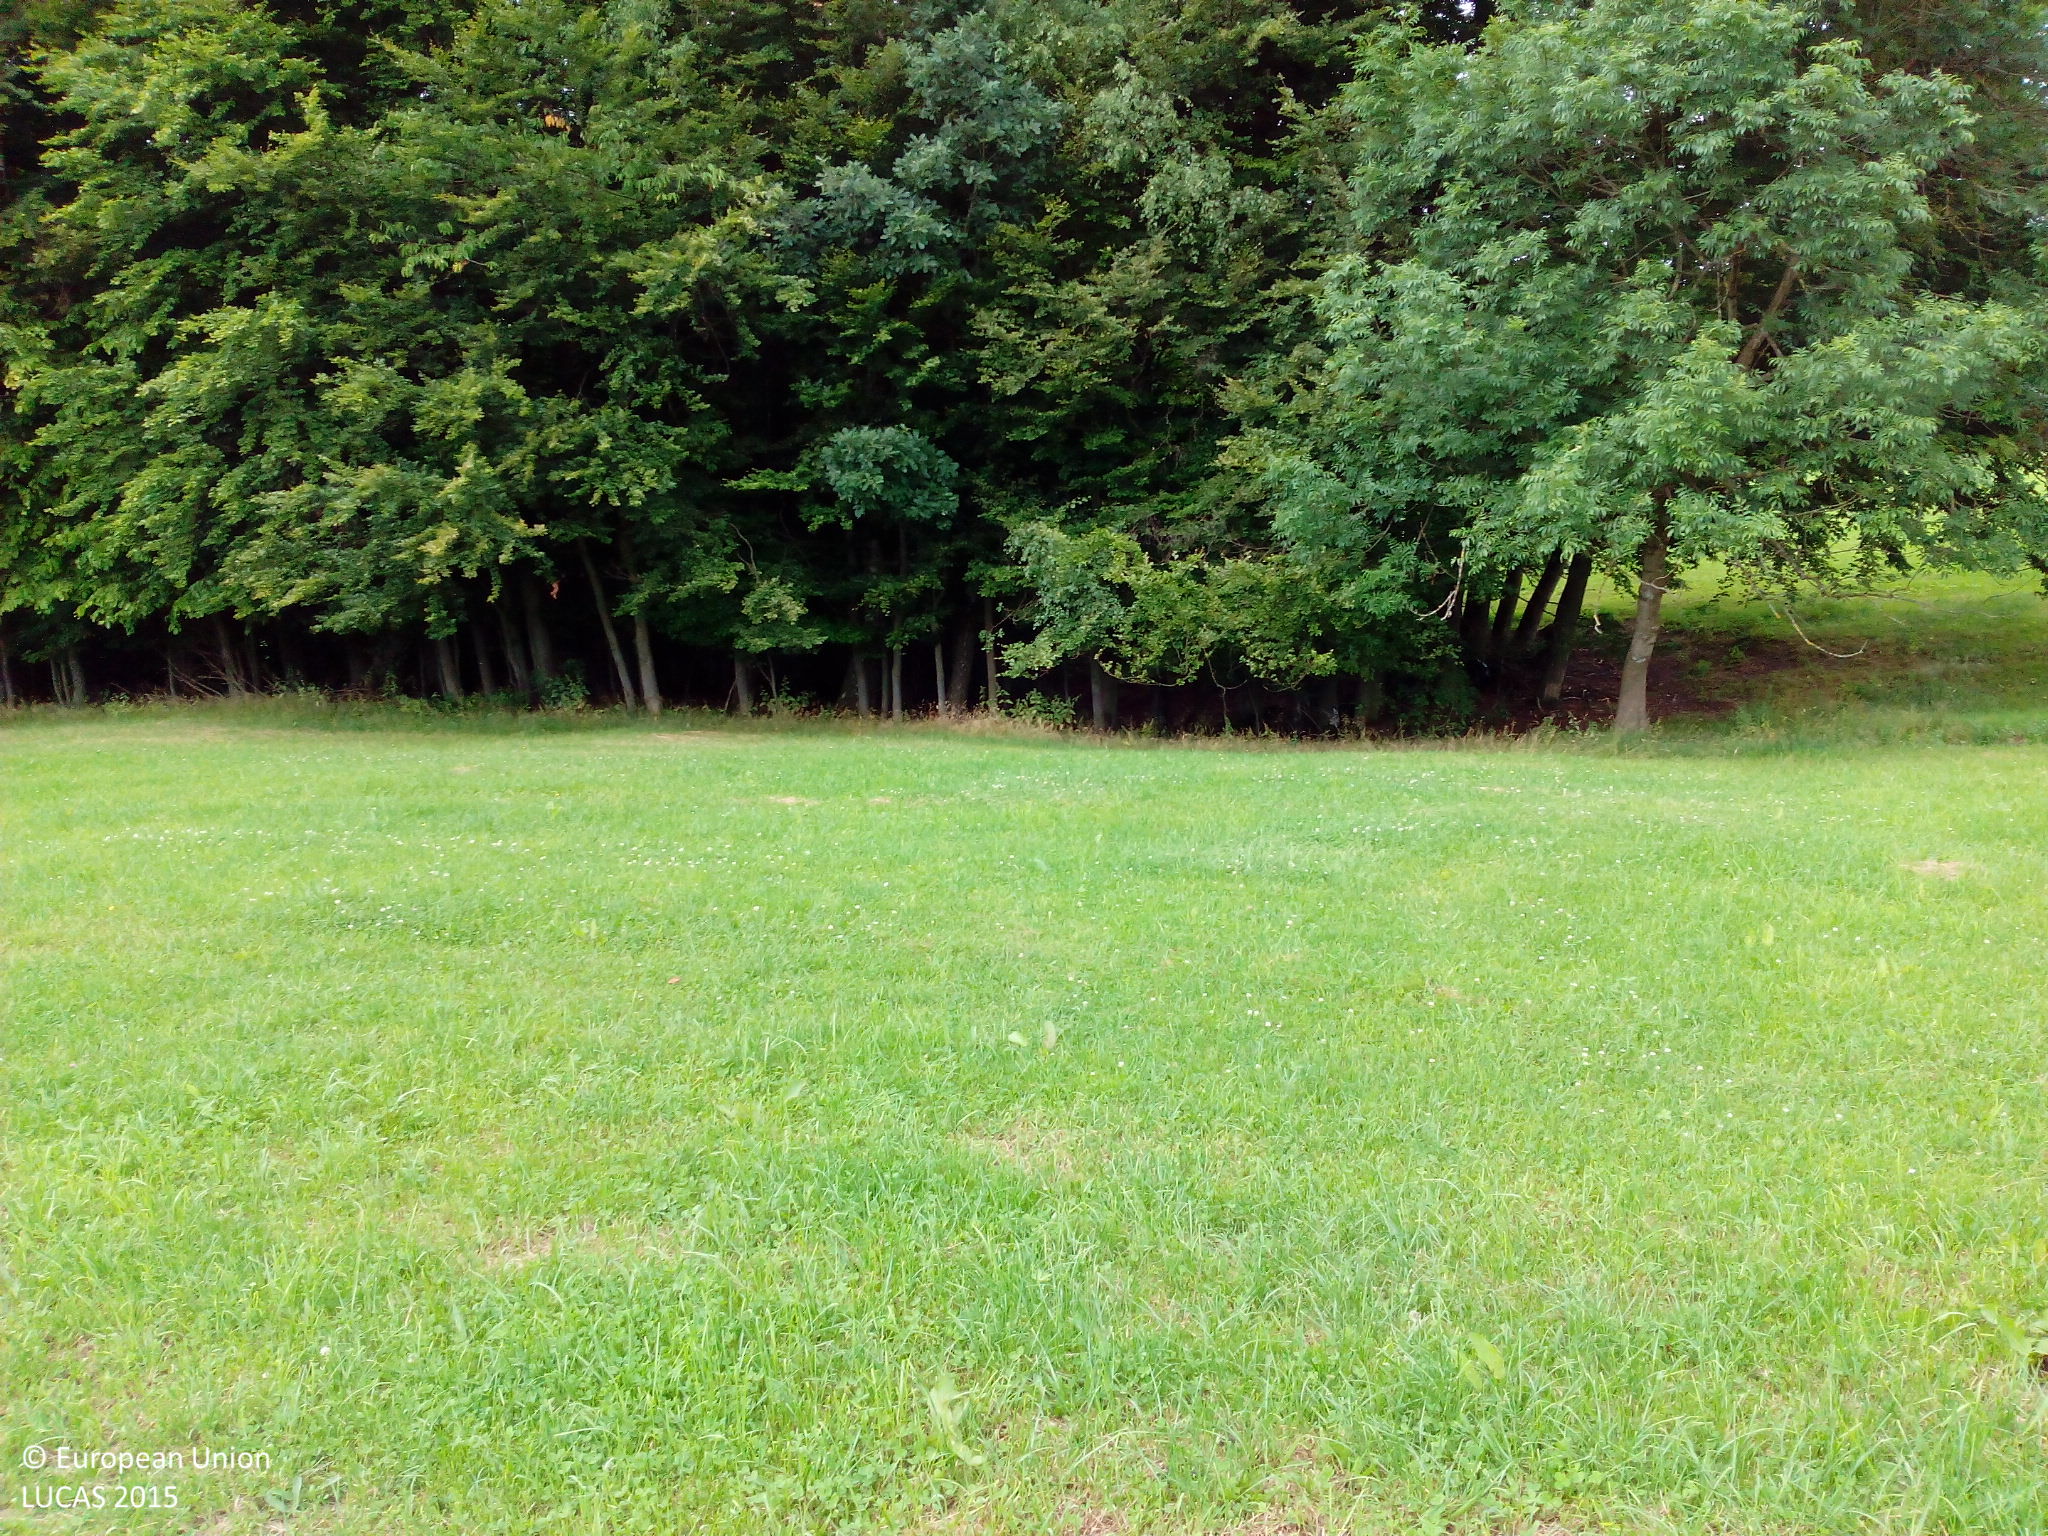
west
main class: Grassland
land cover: Grassland without tree/shrub cover
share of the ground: > 75 %
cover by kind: herbaceous plants 100 %
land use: Agriculture (excluding fallow land and kitchen gardens)
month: July
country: DE
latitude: 50.4899
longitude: 9.9014
